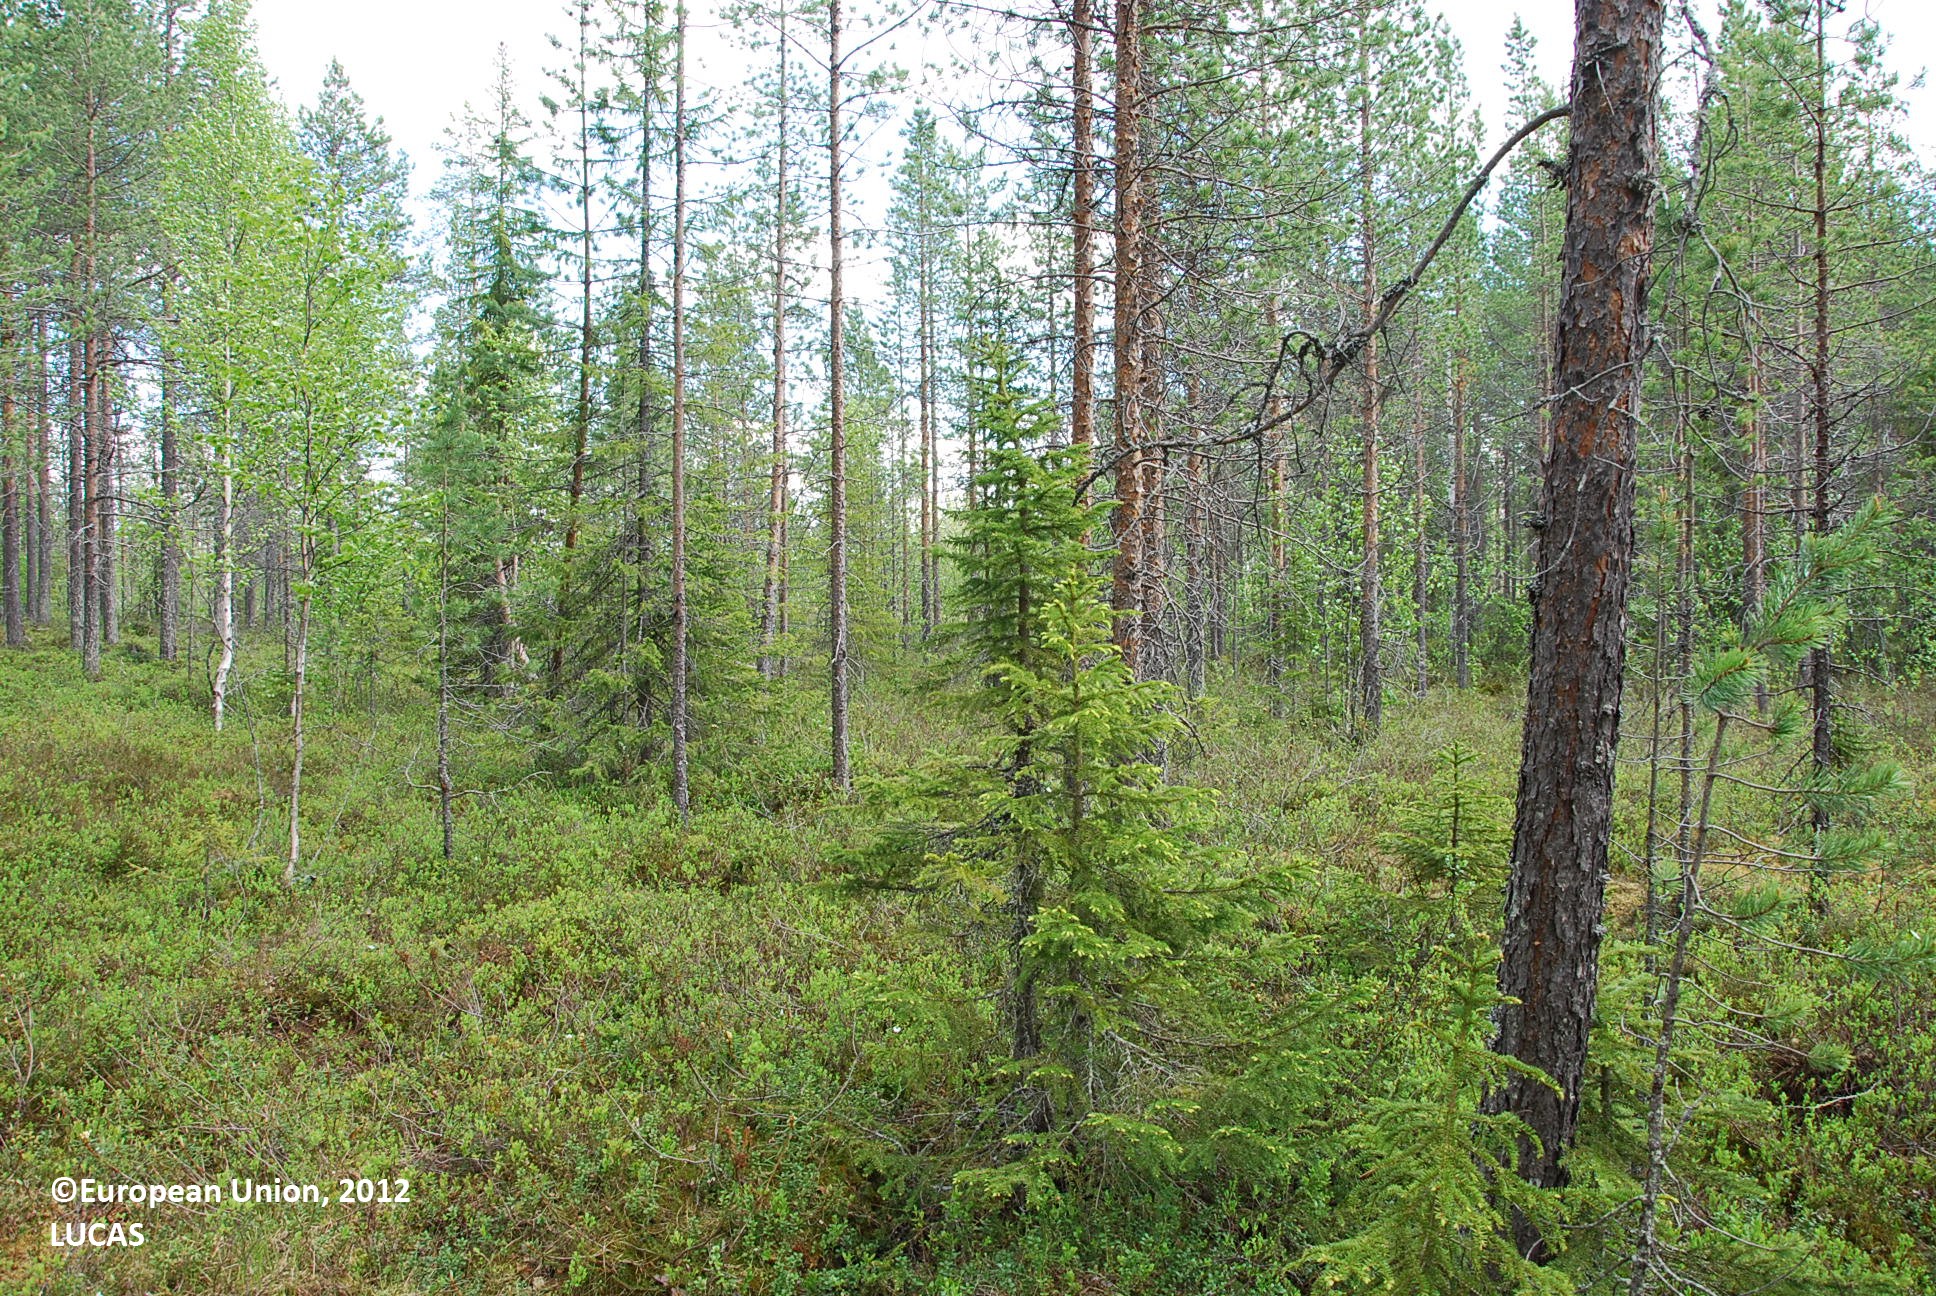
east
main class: Woodland
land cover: Pine dominated coniferous woodland
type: boreal forest
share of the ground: > 75 %
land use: Forestry
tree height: > 5 m
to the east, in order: Pine dominated coniferous woodland; Ditches and canals; Other mixed woodland; Pine dominated mixed woodland; Grassland with sparse tree/shrub cover
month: June
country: FI
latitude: 65.9762
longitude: 27.3994
